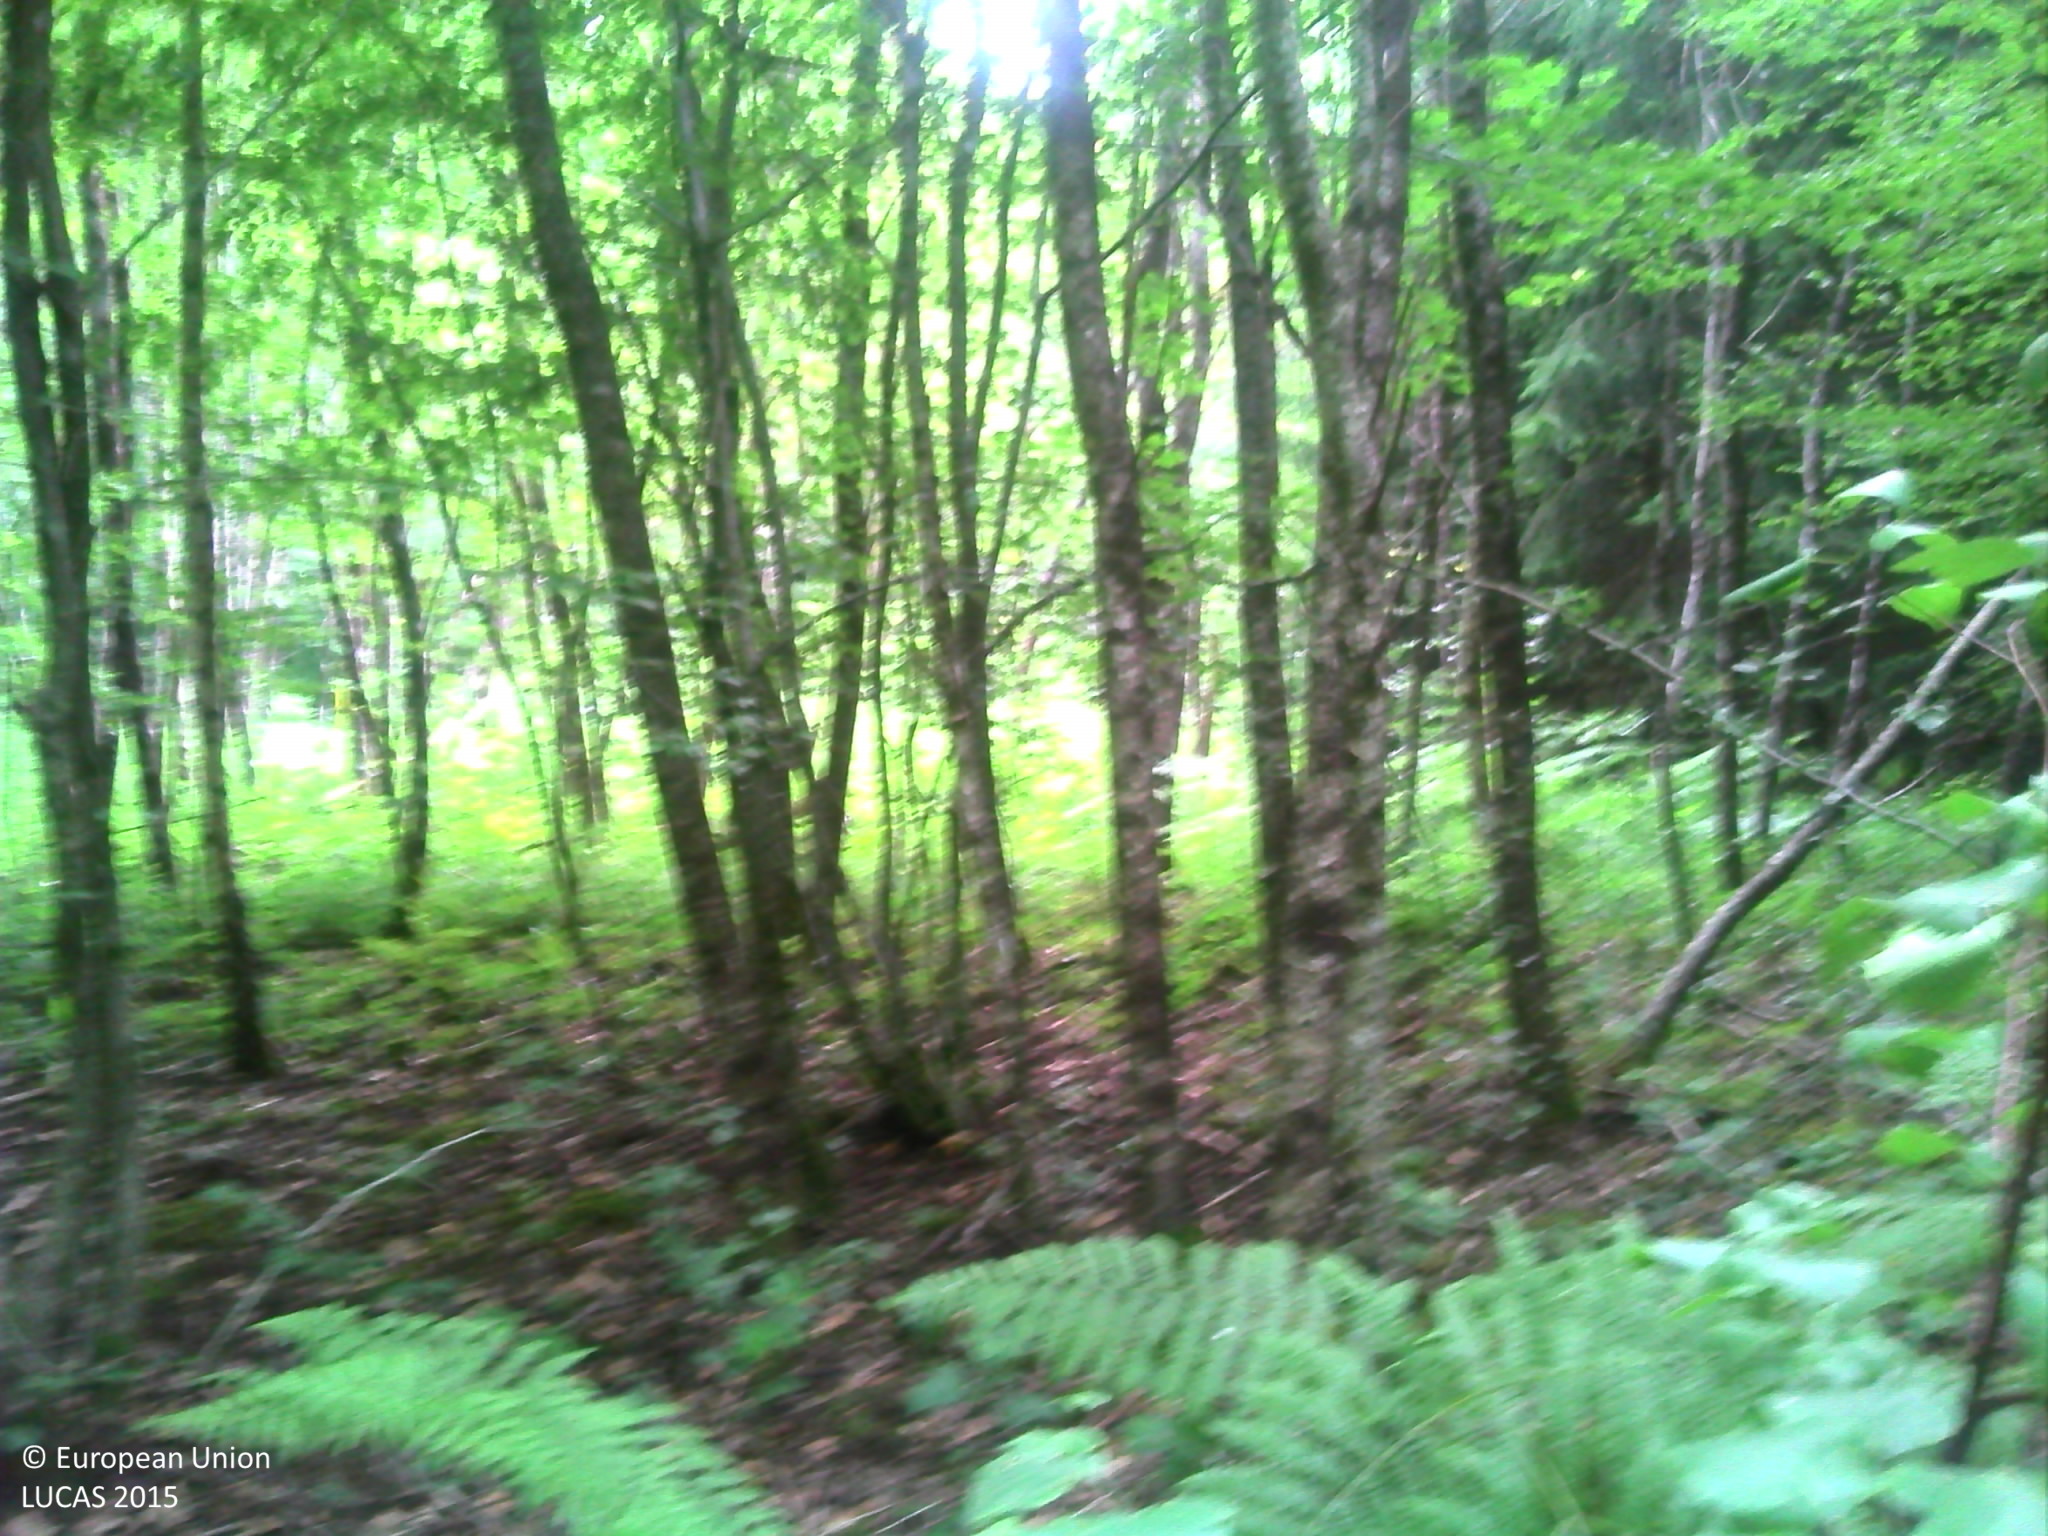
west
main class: Woodland
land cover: Broadleaved woodland
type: beech forest
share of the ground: > 75 %
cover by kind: broadleaved forest trees 90 %, herbaceous plants 10 %
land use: Forestry
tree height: > 5 m
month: June
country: FR
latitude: 47.8390
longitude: 6.3535
